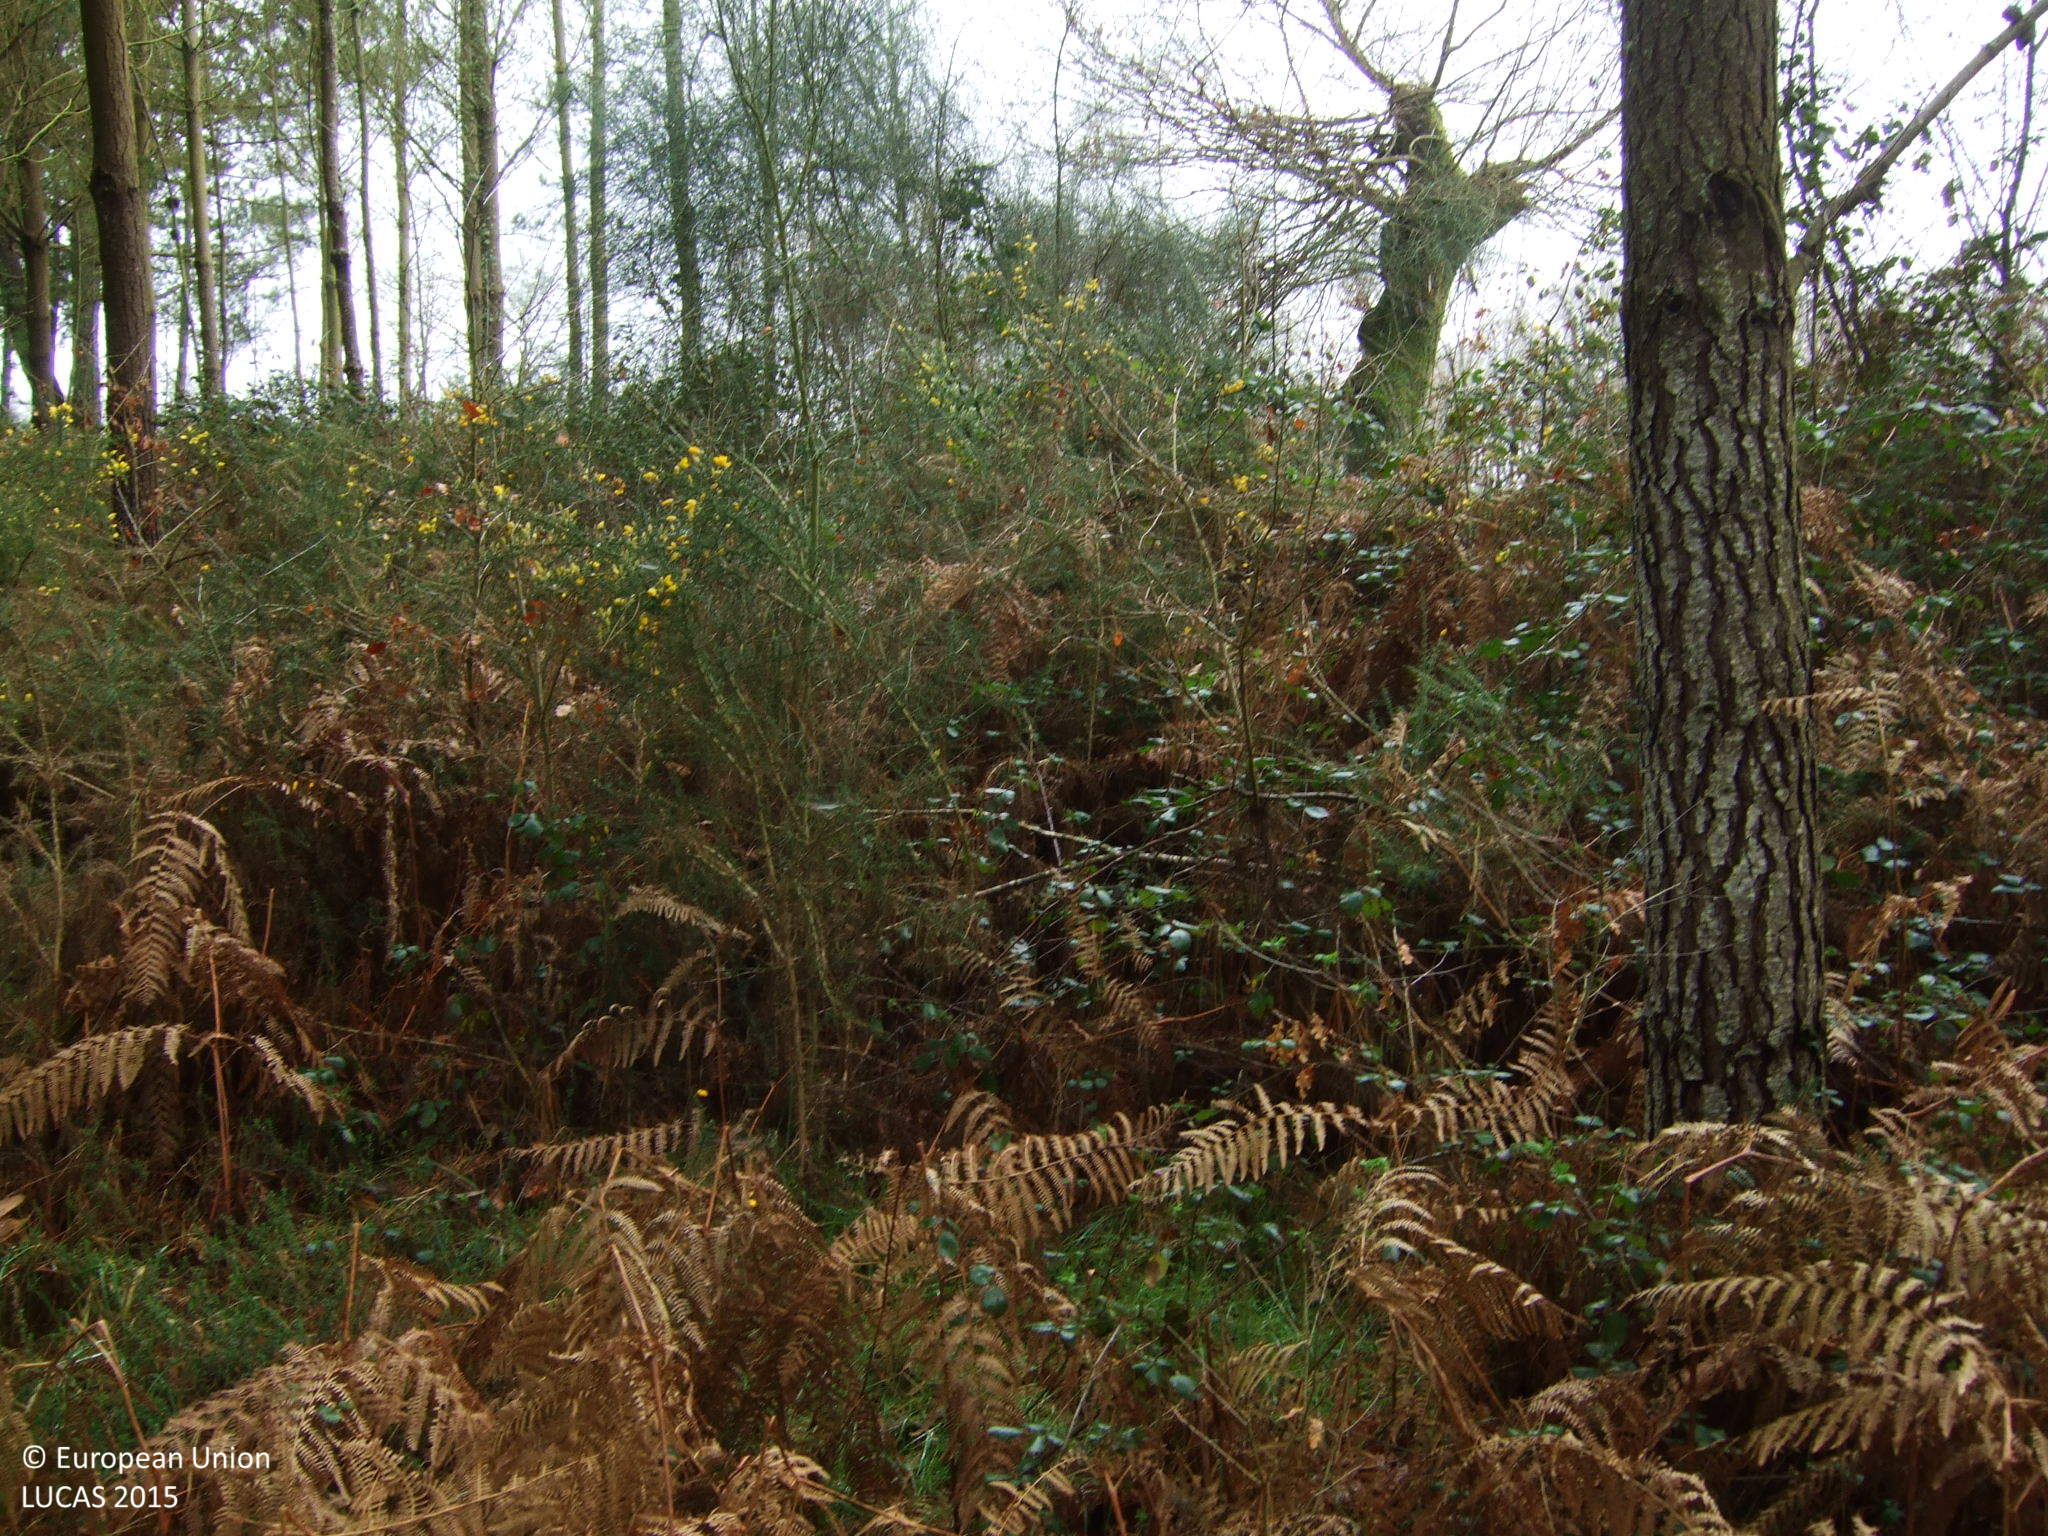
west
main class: Woodland
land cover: Pine dominated coniferous woodland
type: exotic forest
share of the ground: > 75 %
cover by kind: coniferous forest trees 90 %, shrubs 10 %
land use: Forestry
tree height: > 5 m
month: March
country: ES
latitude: 42.8014
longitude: -7.8745
